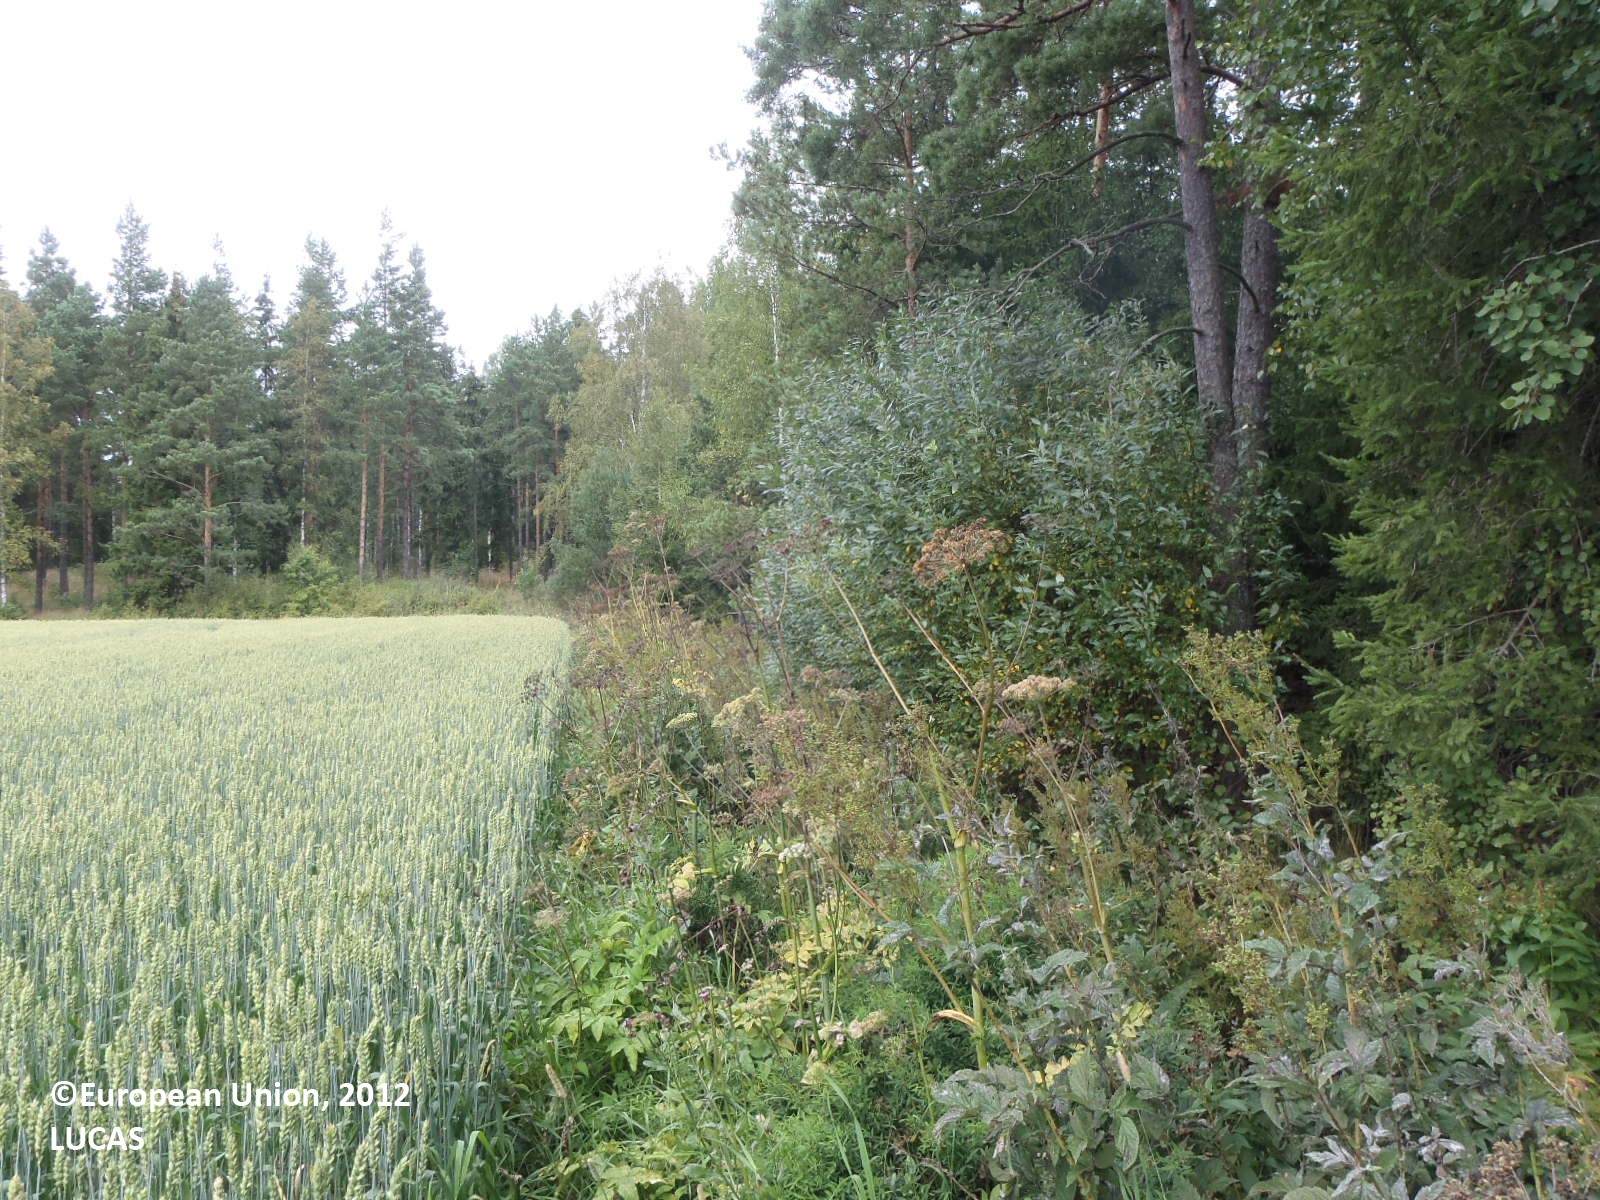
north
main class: Cropland
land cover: Barley
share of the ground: > 75 %
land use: Agriculture (excluding fallow land and kitchen gardens)
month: August
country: FI
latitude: 60.5617
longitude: 22.1951
